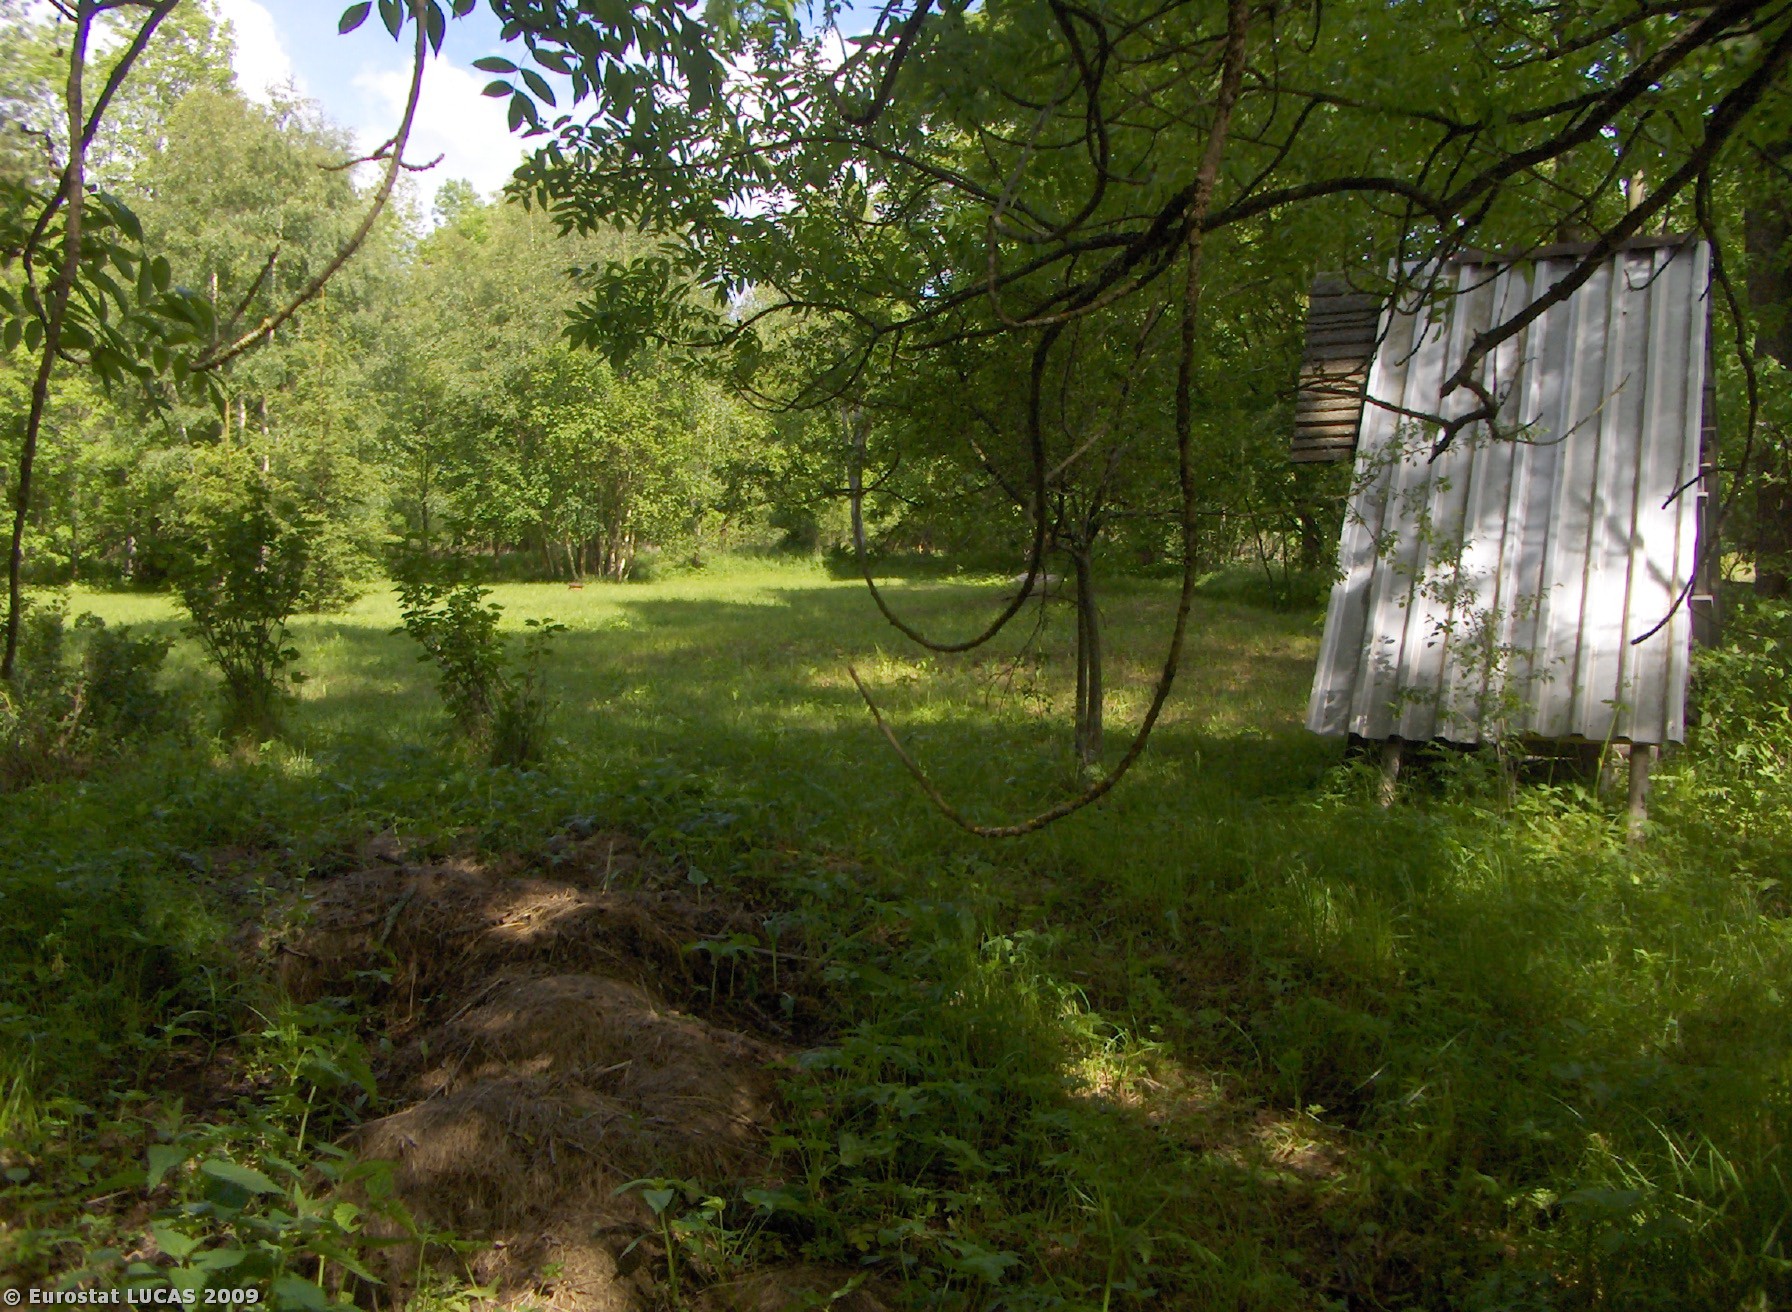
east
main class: Woodland
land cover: Broadleaved woodland
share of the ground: > 75 %
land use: Nature reserves
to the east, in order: Broadleaved woodland; Grassland without tree/shrub cover; Broadleaved woodland; Tracks; Fences; Broadleaved woodland; Shrubland with sparse tree cover; Broadleaved woodland; Fences; Grassland without tree/shrub cover; Fences; Grassland without tree/shrub cover
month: June
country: CZ
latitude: 48.9635
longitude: 13.9477
